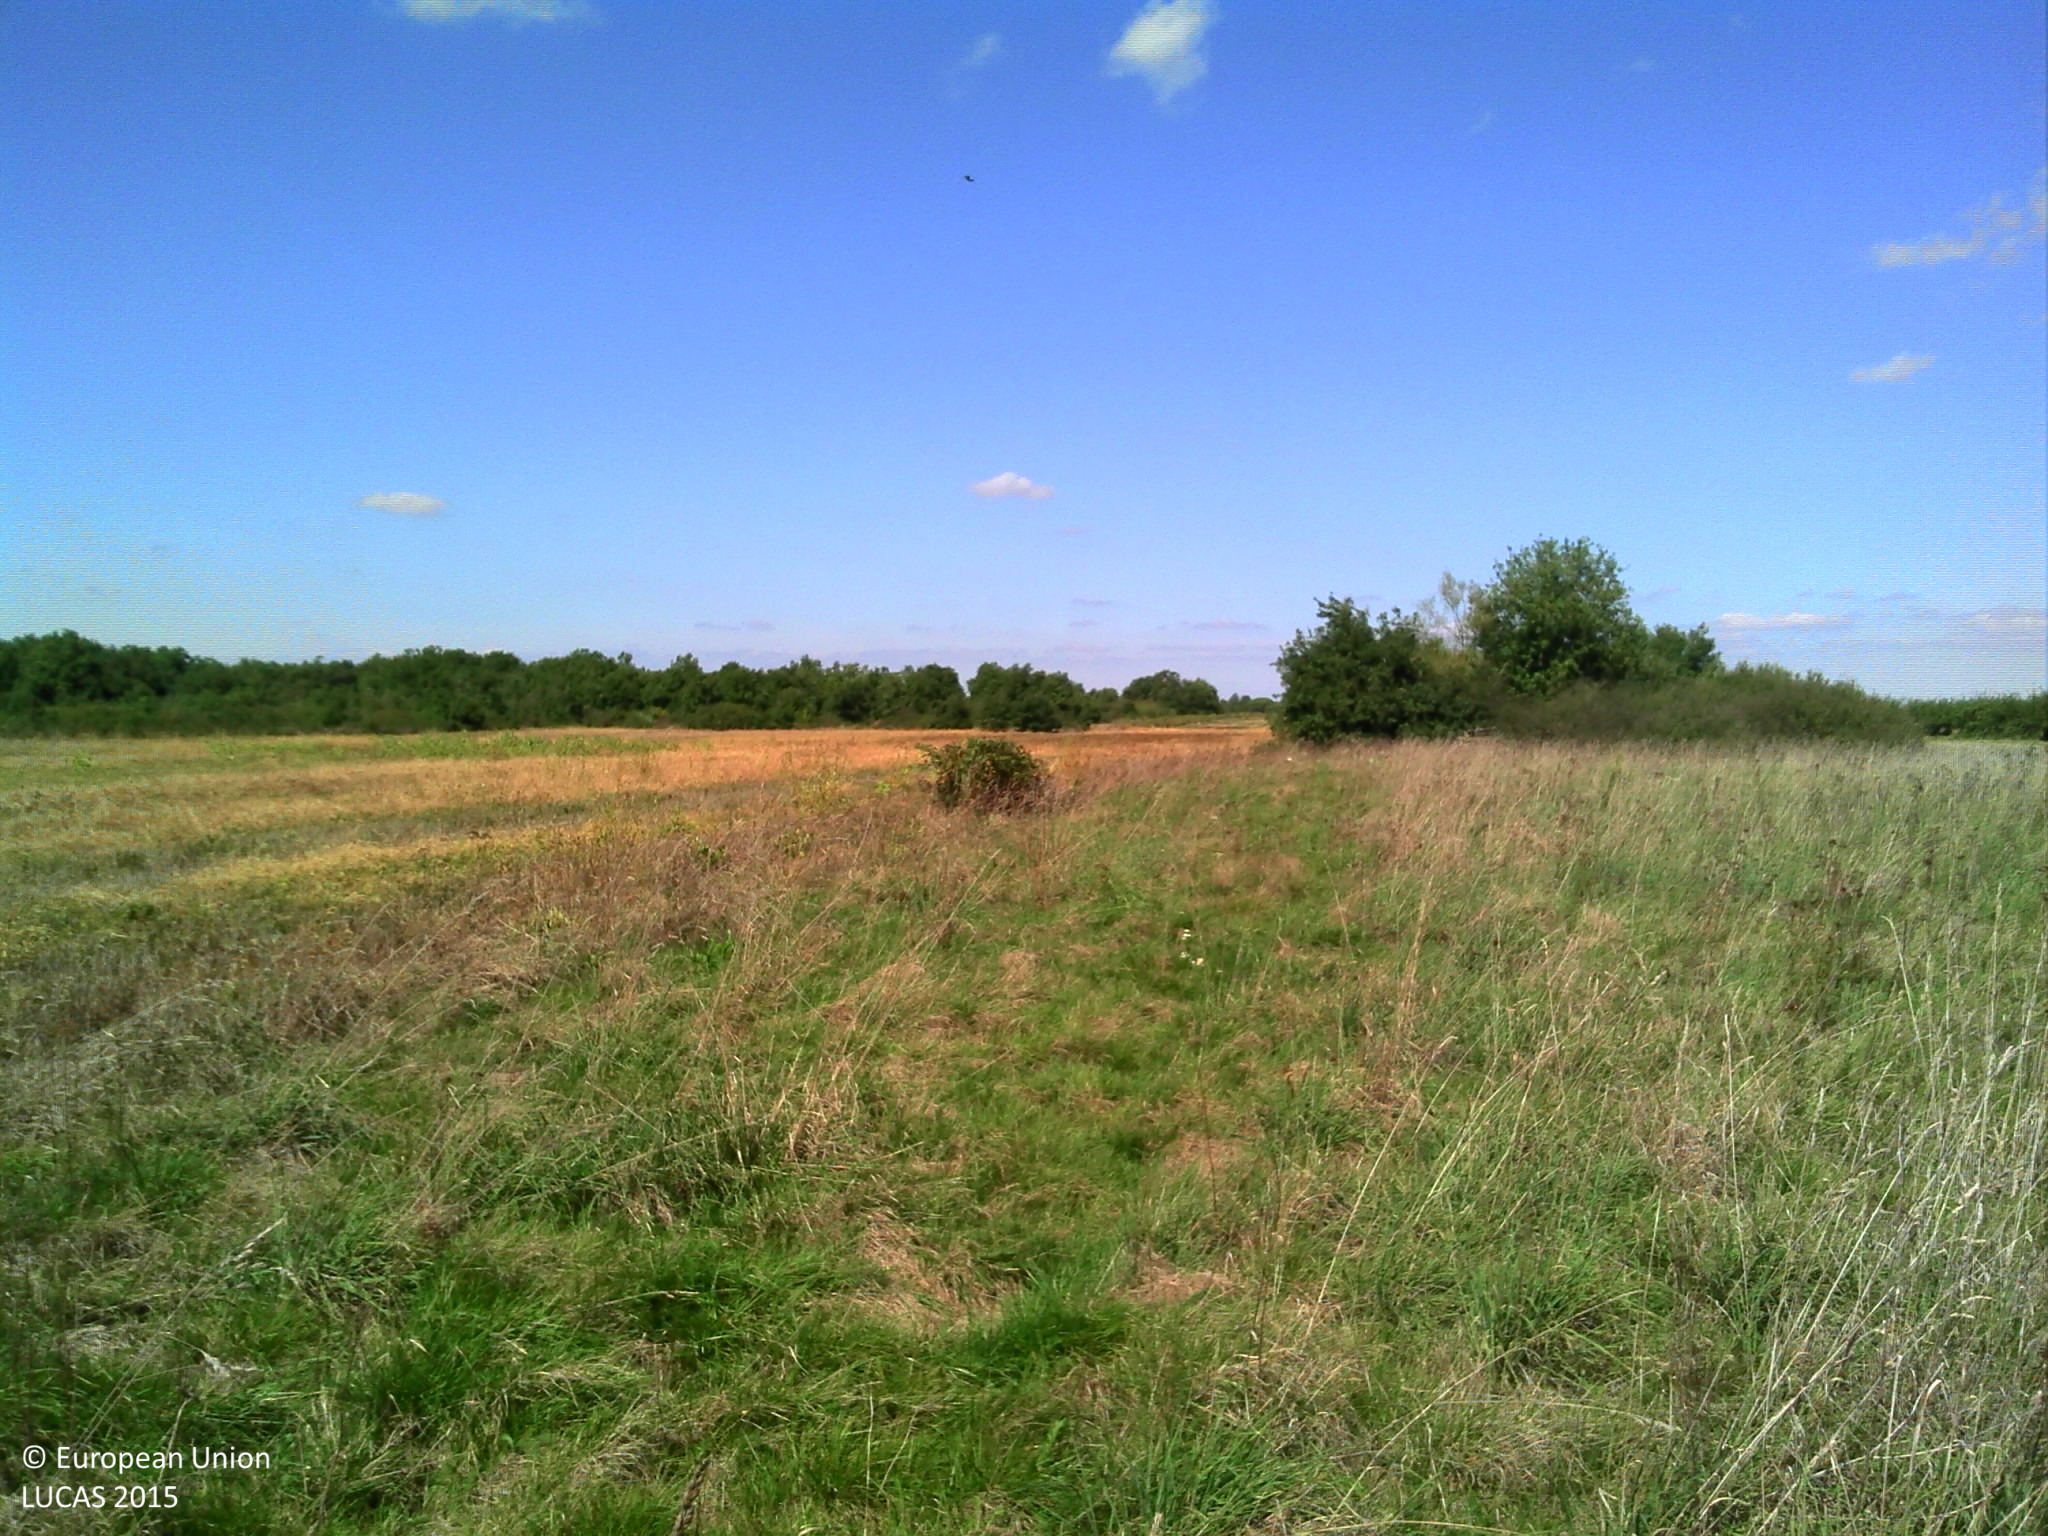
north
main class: Grassland
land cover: Grassland without tree/shrub cover
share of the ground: > 75 %
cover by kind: herbaceous plants 100 %
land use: Agriculture (excluding fallow land and kitchen gardens)
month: September
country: FR
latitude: 43.8738
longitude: 1.2767
